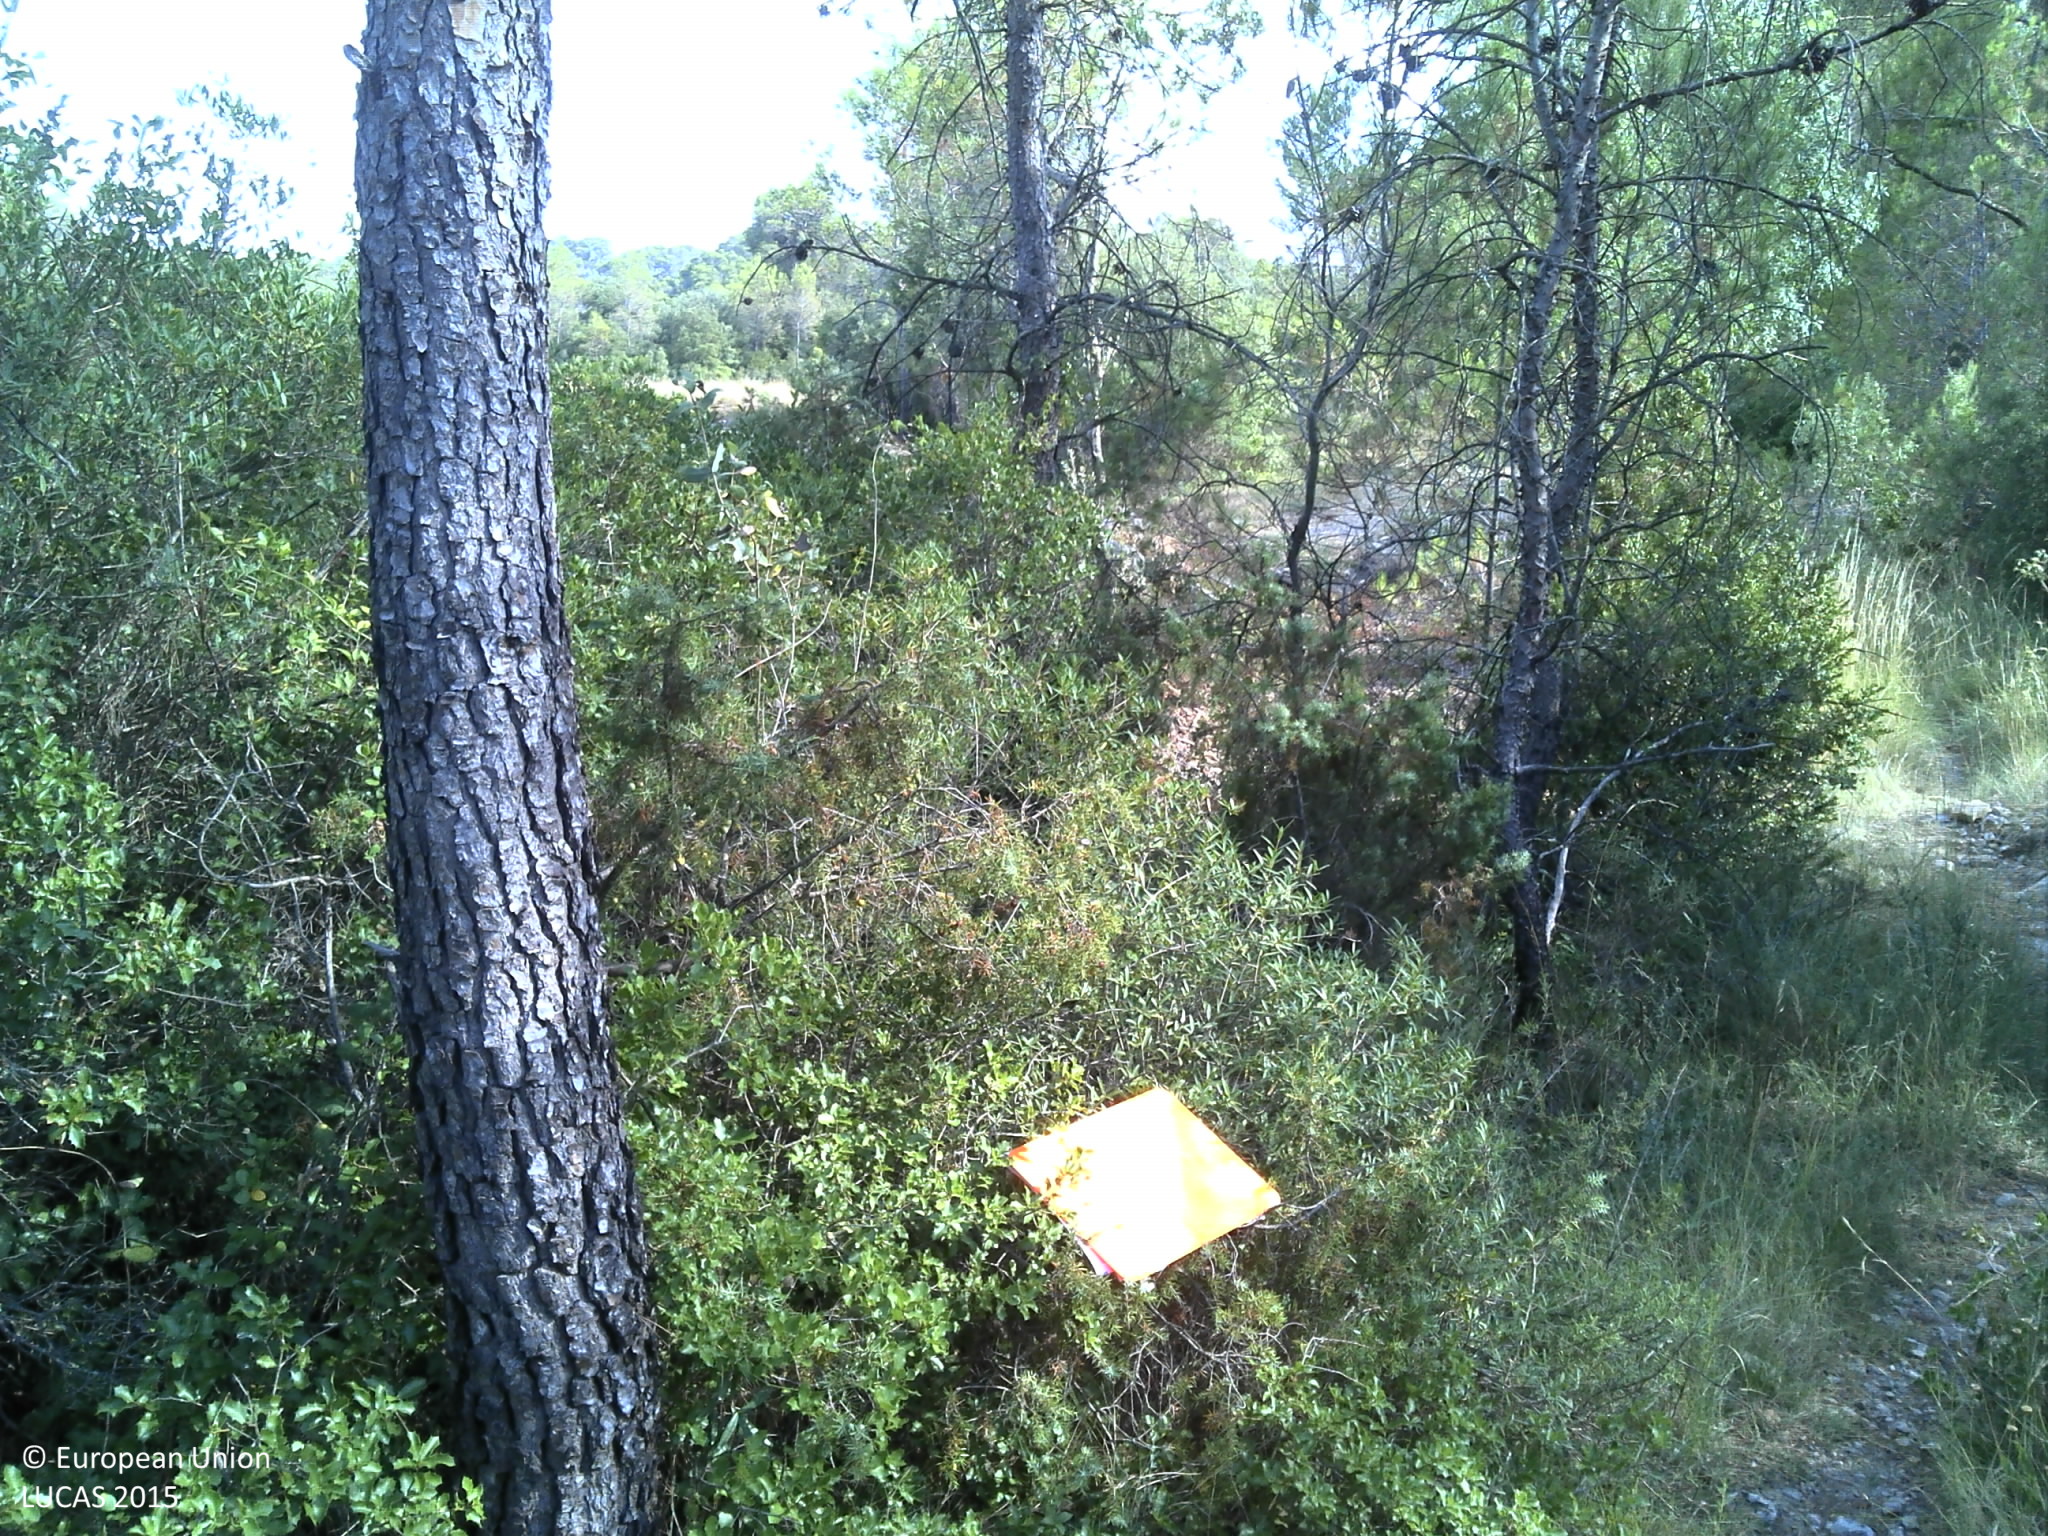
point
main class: Woodland
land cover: Pine dominated mixed woodland
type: coniferous forest of the mediterranean region
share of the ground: > 75 %
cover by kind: coniferous forest trees 50 %, broadleaved forest trees 25 %, herbaceous plants 15 %, unconsolidated bare surface 10 %
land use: Semi-natural and natural areas not in use
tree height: > 5 m
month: July
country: FR
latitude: 43.7780
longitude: 3.9827
